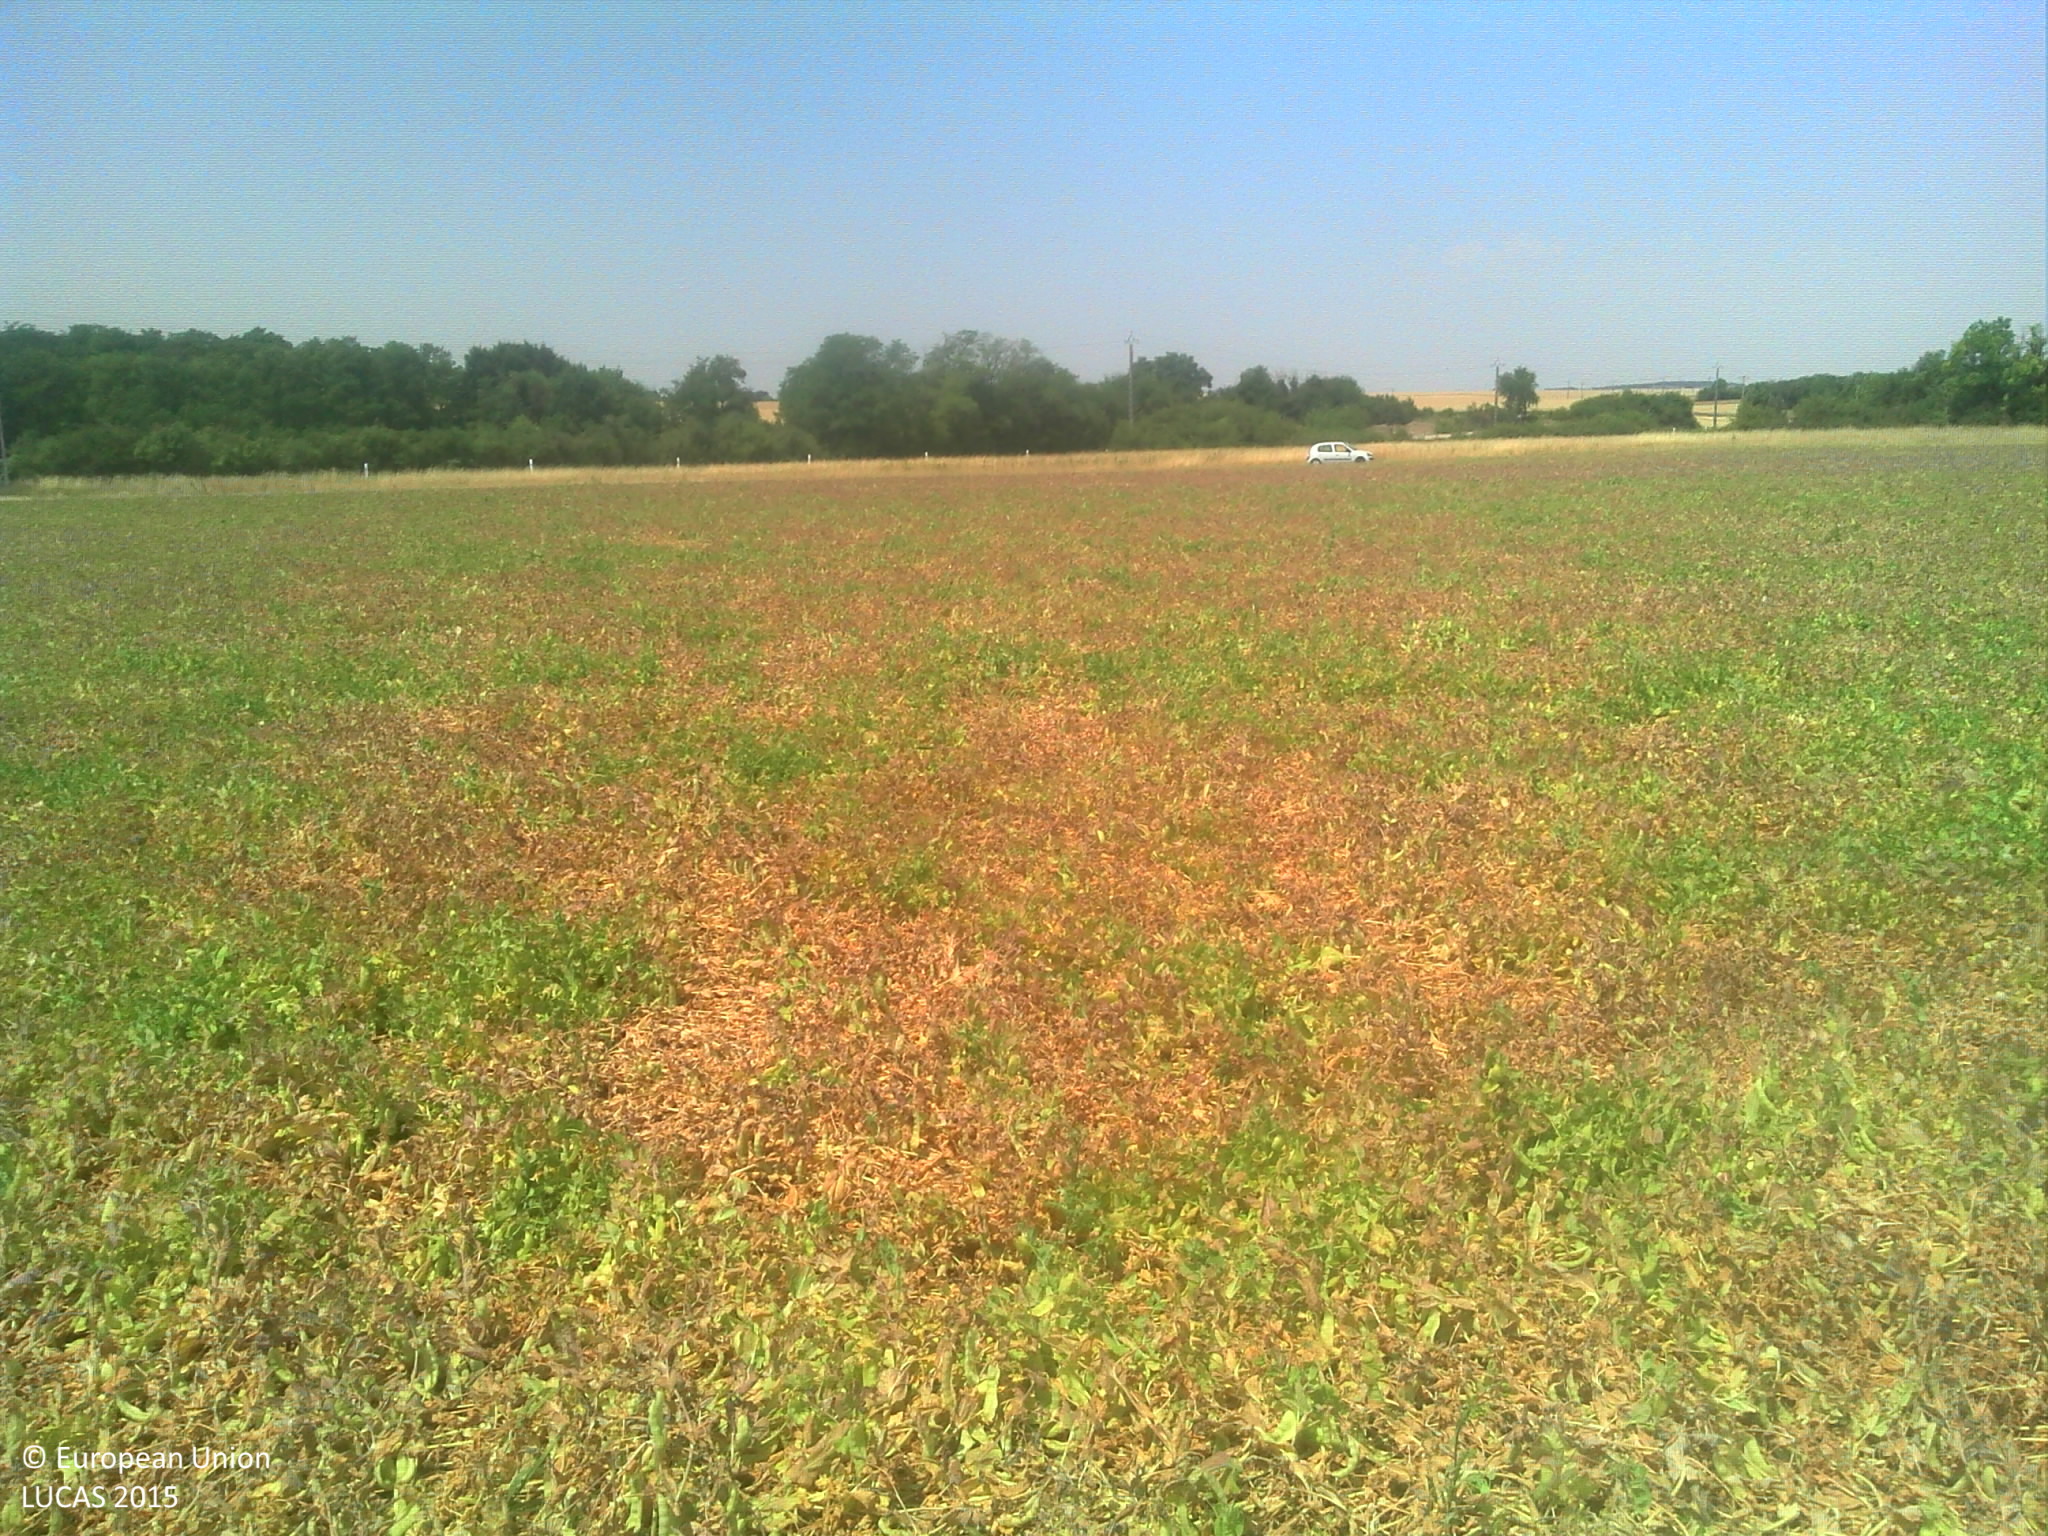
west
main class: Cropland
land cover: Durum wheat
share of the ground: > 75 %
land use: Agriculture (excluding fallow land and kitchen gardens)
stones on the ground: 10 - 25 %
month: July
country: FR
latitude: 47.7313
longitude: 1.4917
